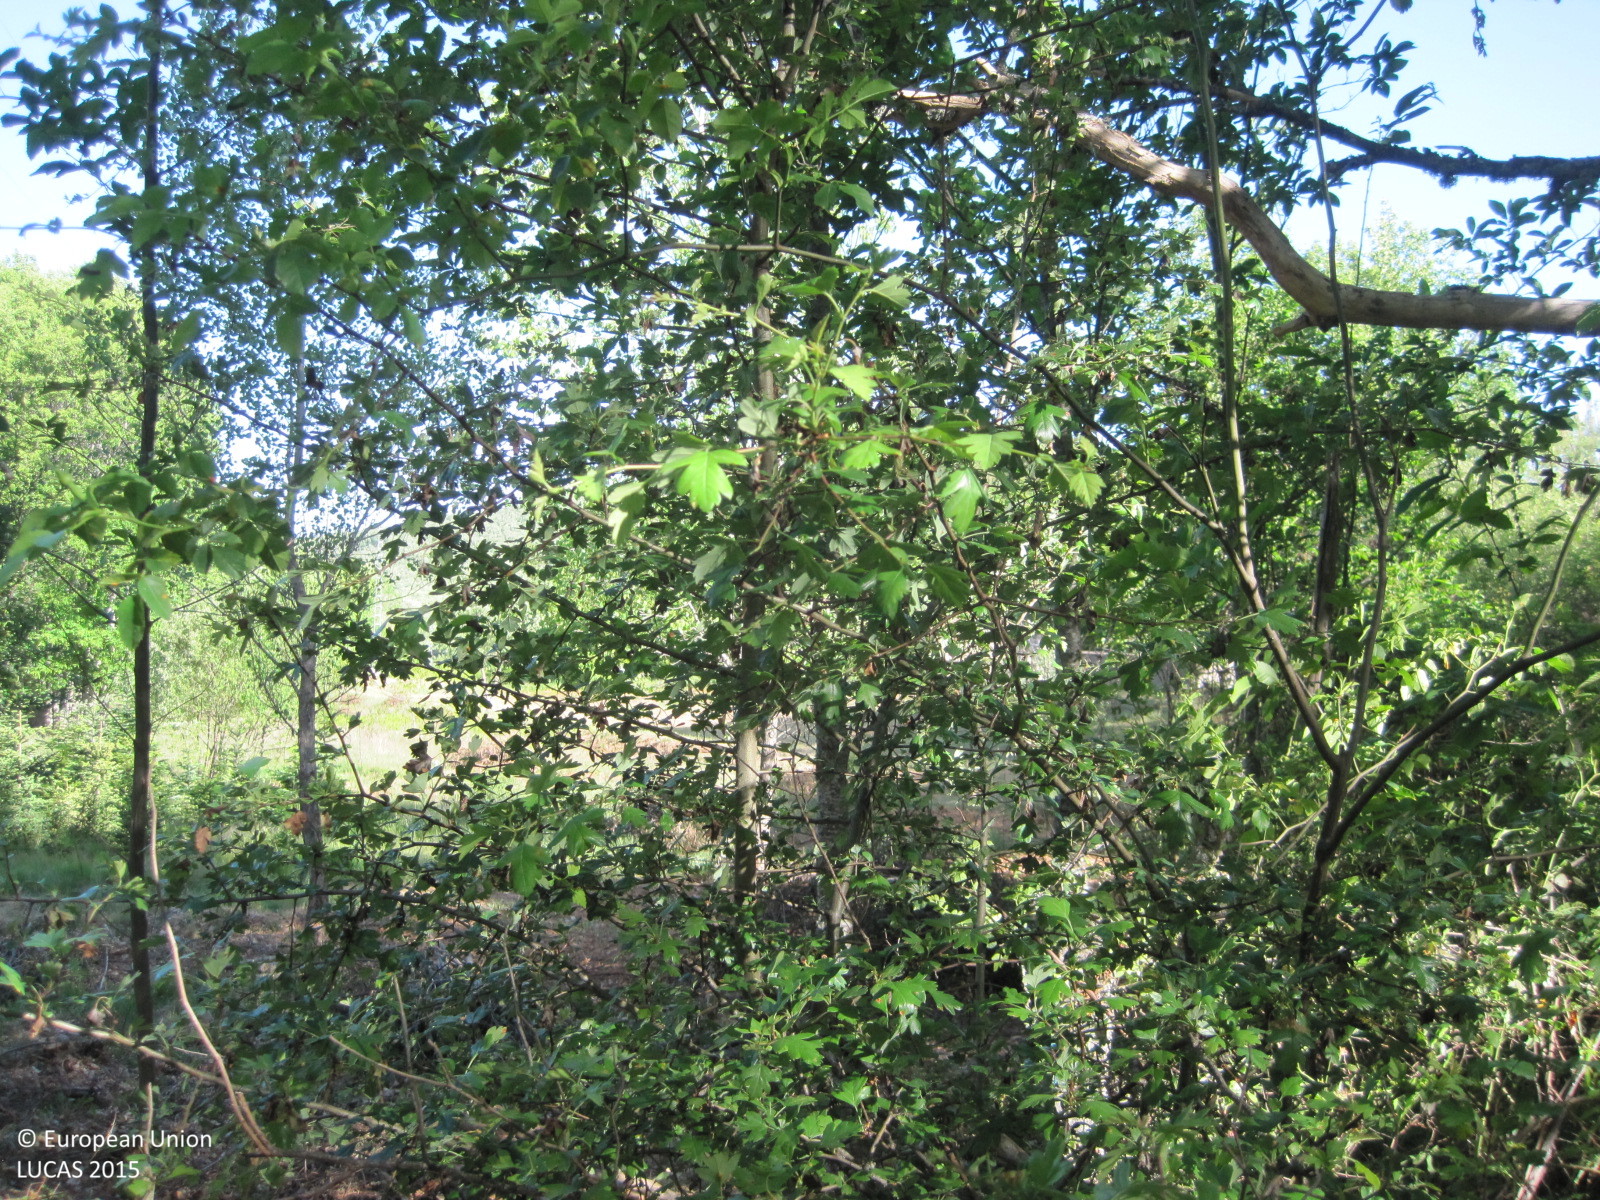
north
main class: Grassland
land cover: Grassland without tree/shrub cover
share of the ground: > 75 %
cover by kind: herbaceous plants 100 %
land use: Agriculture (excluding fallow land and kitchen gardens)
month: May
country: ES
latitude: 40.1395
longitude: -4.7320
